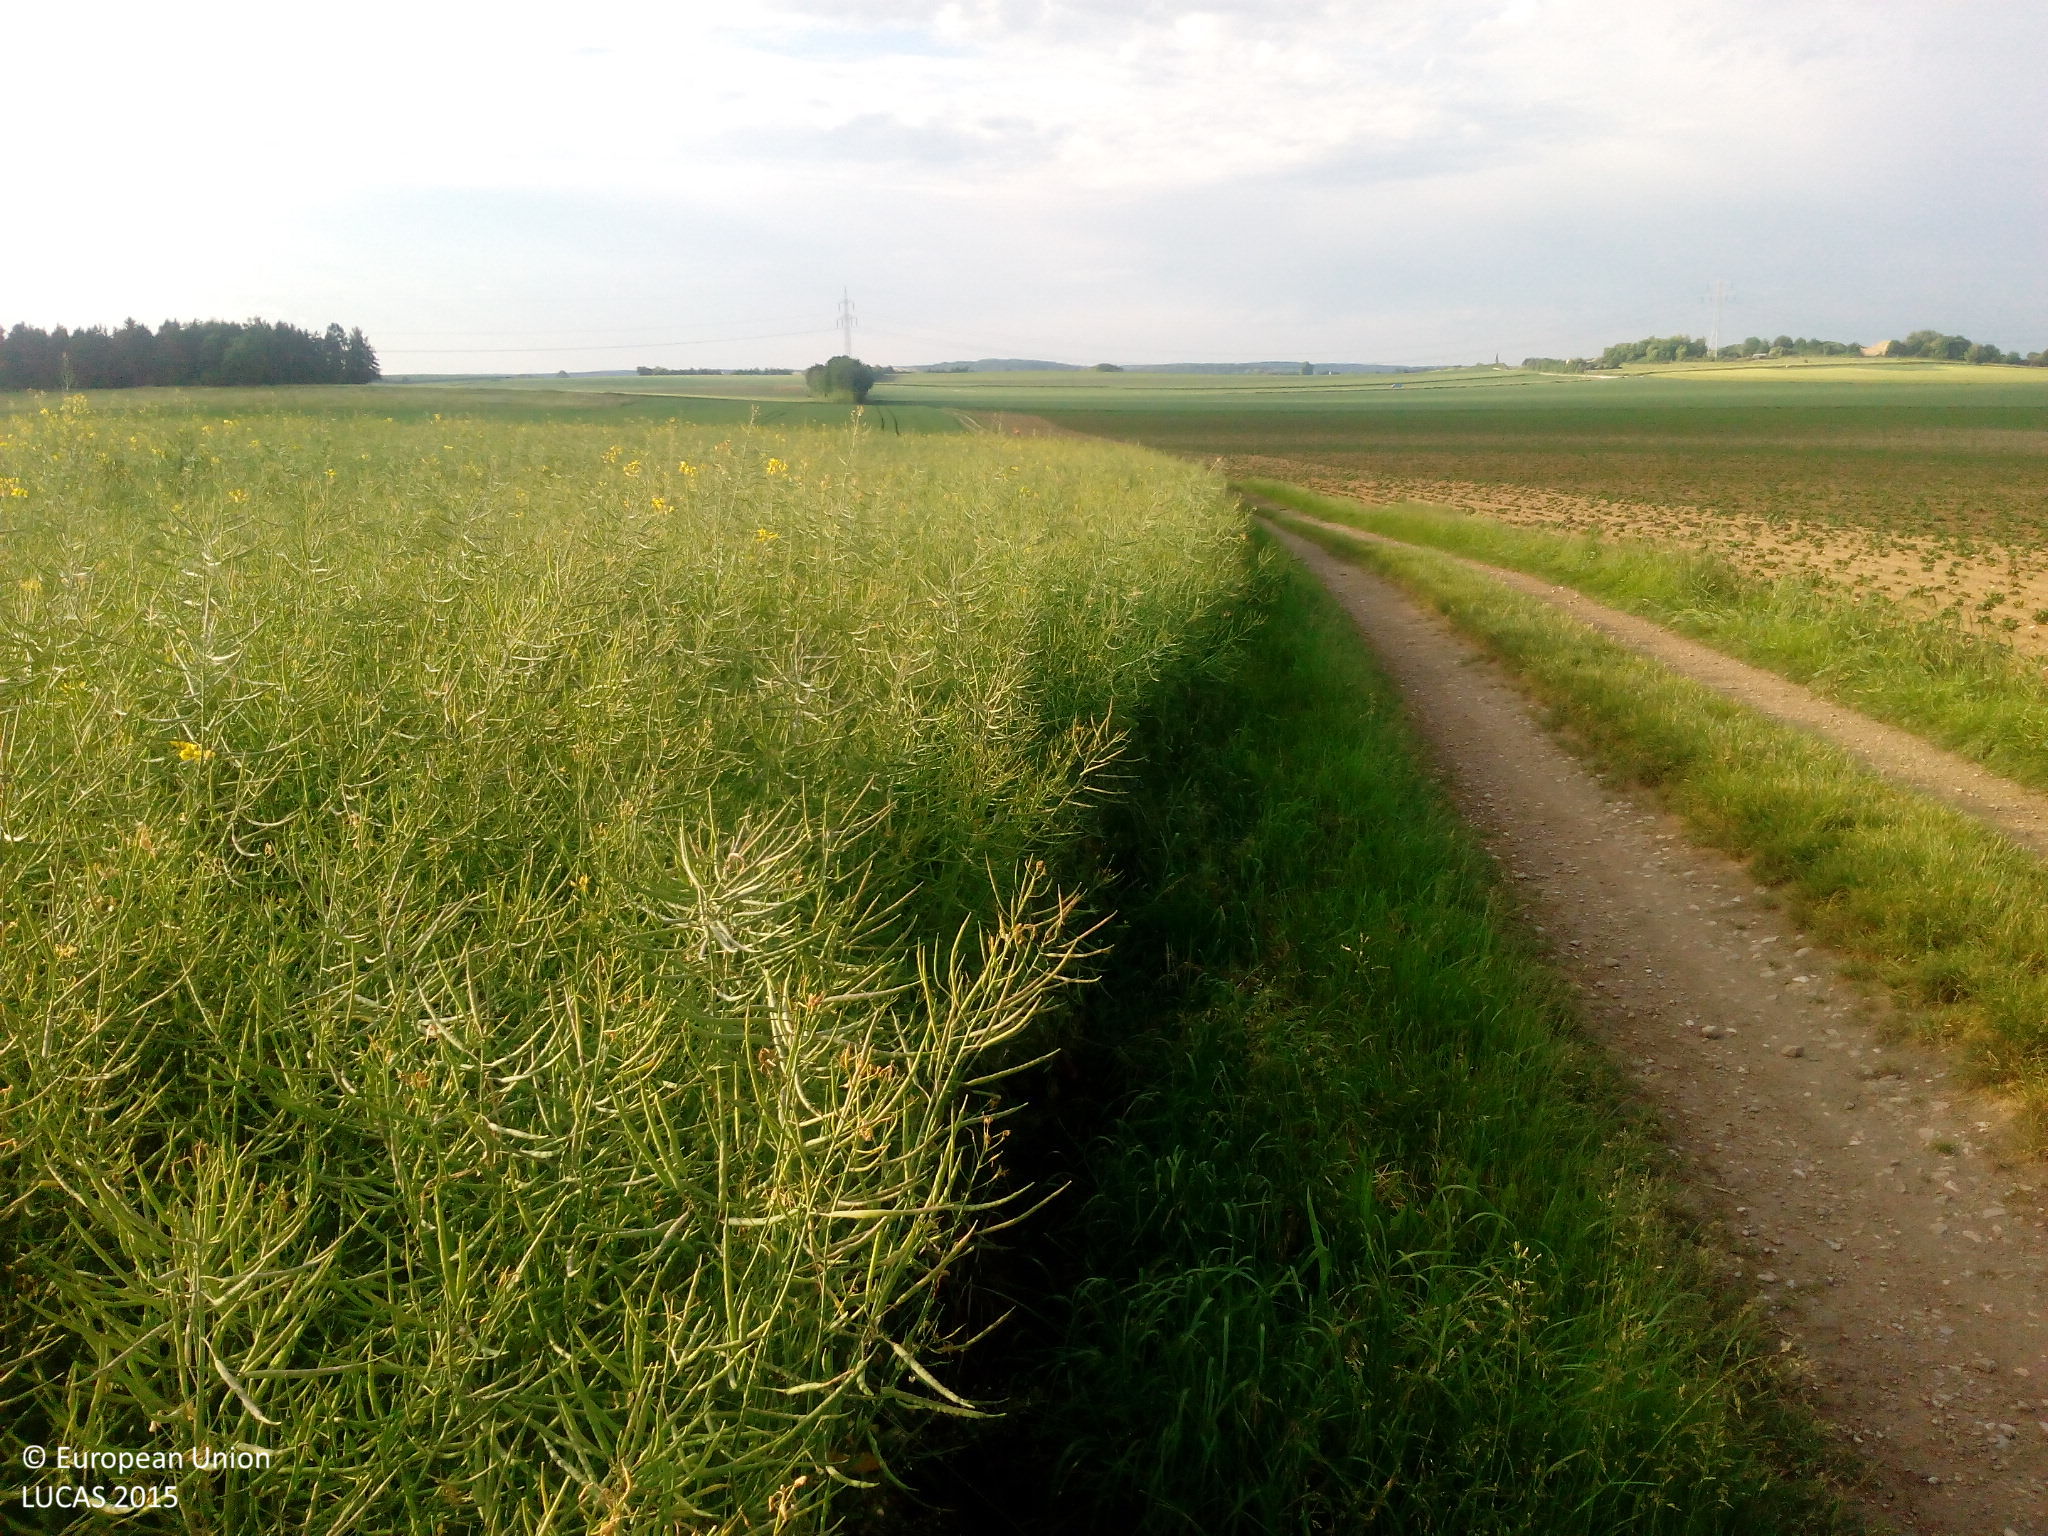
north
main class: Cropland
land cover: Rape and turnip rape
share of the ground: > 75 %
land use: Agriculture (excluding fallow land and kitchen gardens)
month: May
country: DE
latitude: 48.7883
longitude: 11.5646
